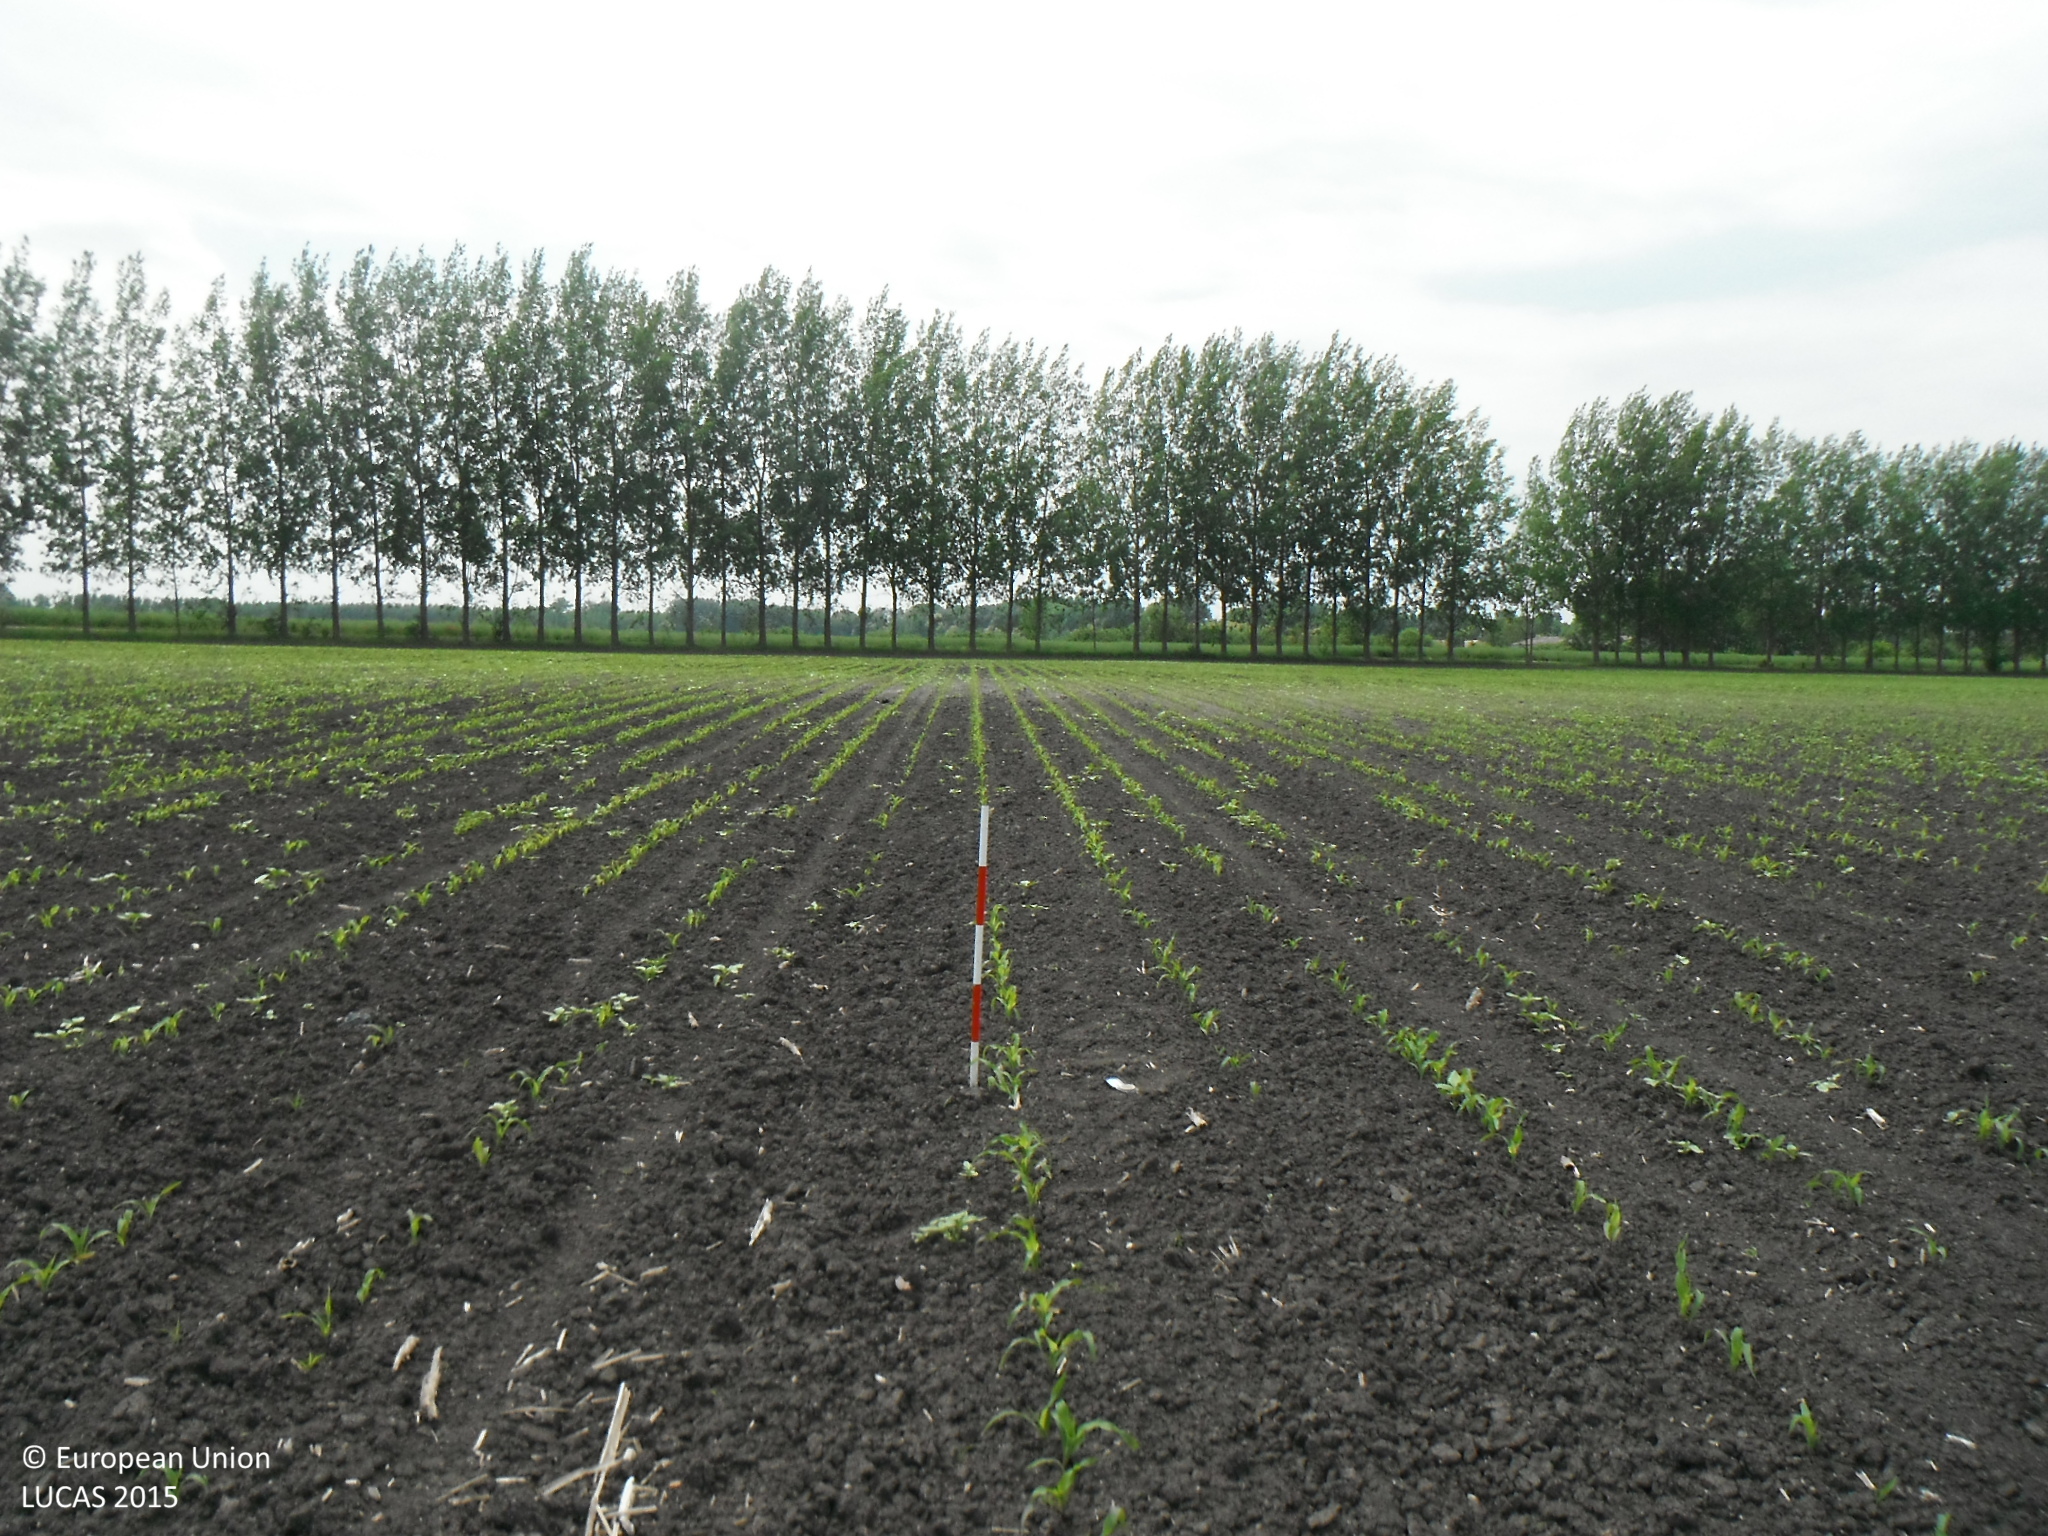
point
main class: Cropland
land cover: Maize
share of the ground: < 10 %
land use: Agriculture (excluding fallow land and kitchen gardens)
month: May
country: SK
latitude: 47.8620
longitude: 17.7231
